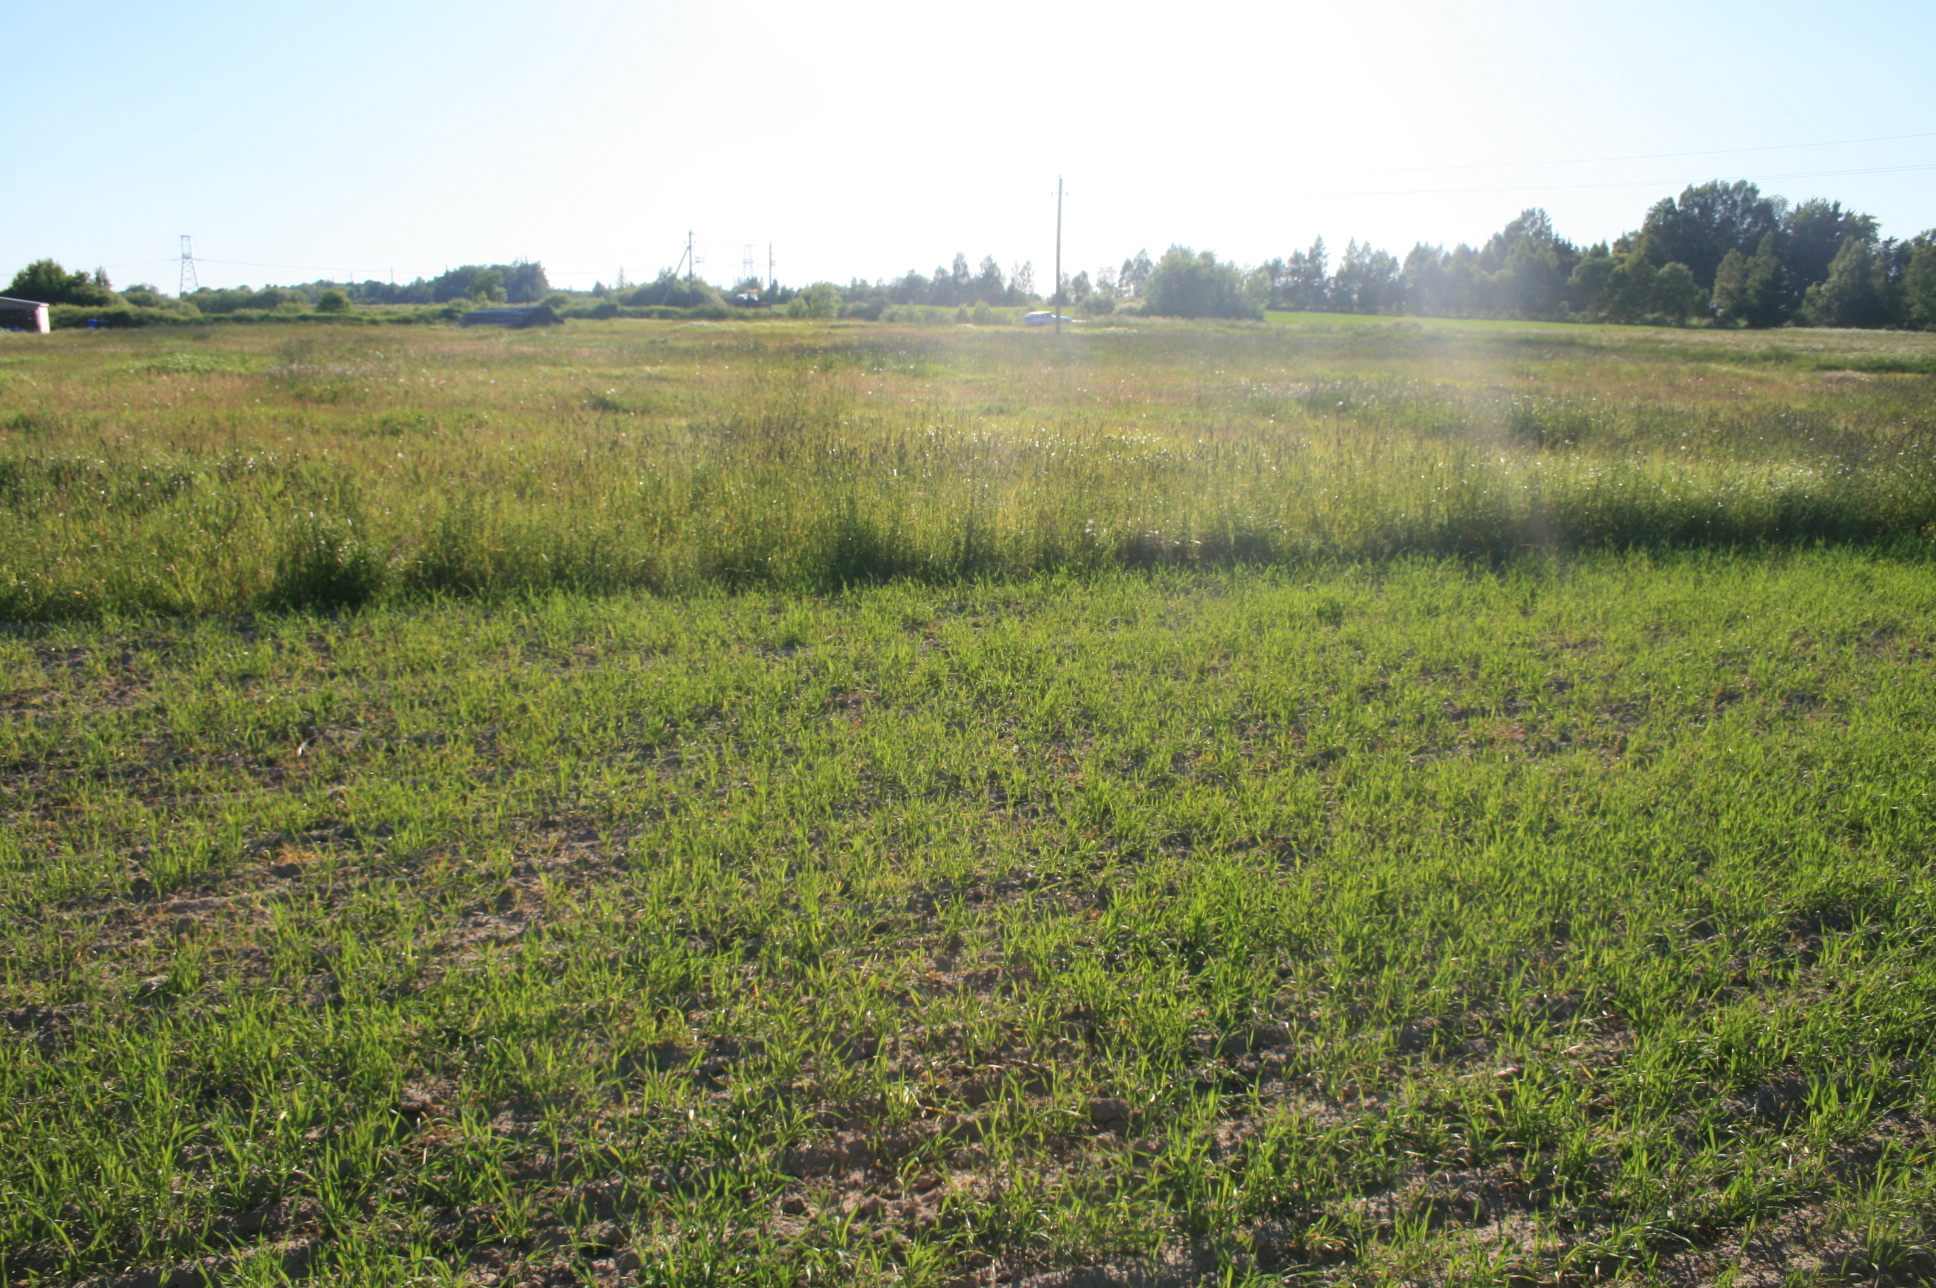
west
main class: Cropland
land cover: Barley
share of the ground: 50 - 75 %
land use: Agriculture (excluding fallow land and kitchen gardens)
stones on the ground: < 10 %
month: June
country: LT
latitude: 55.9210
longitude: 21.3235
